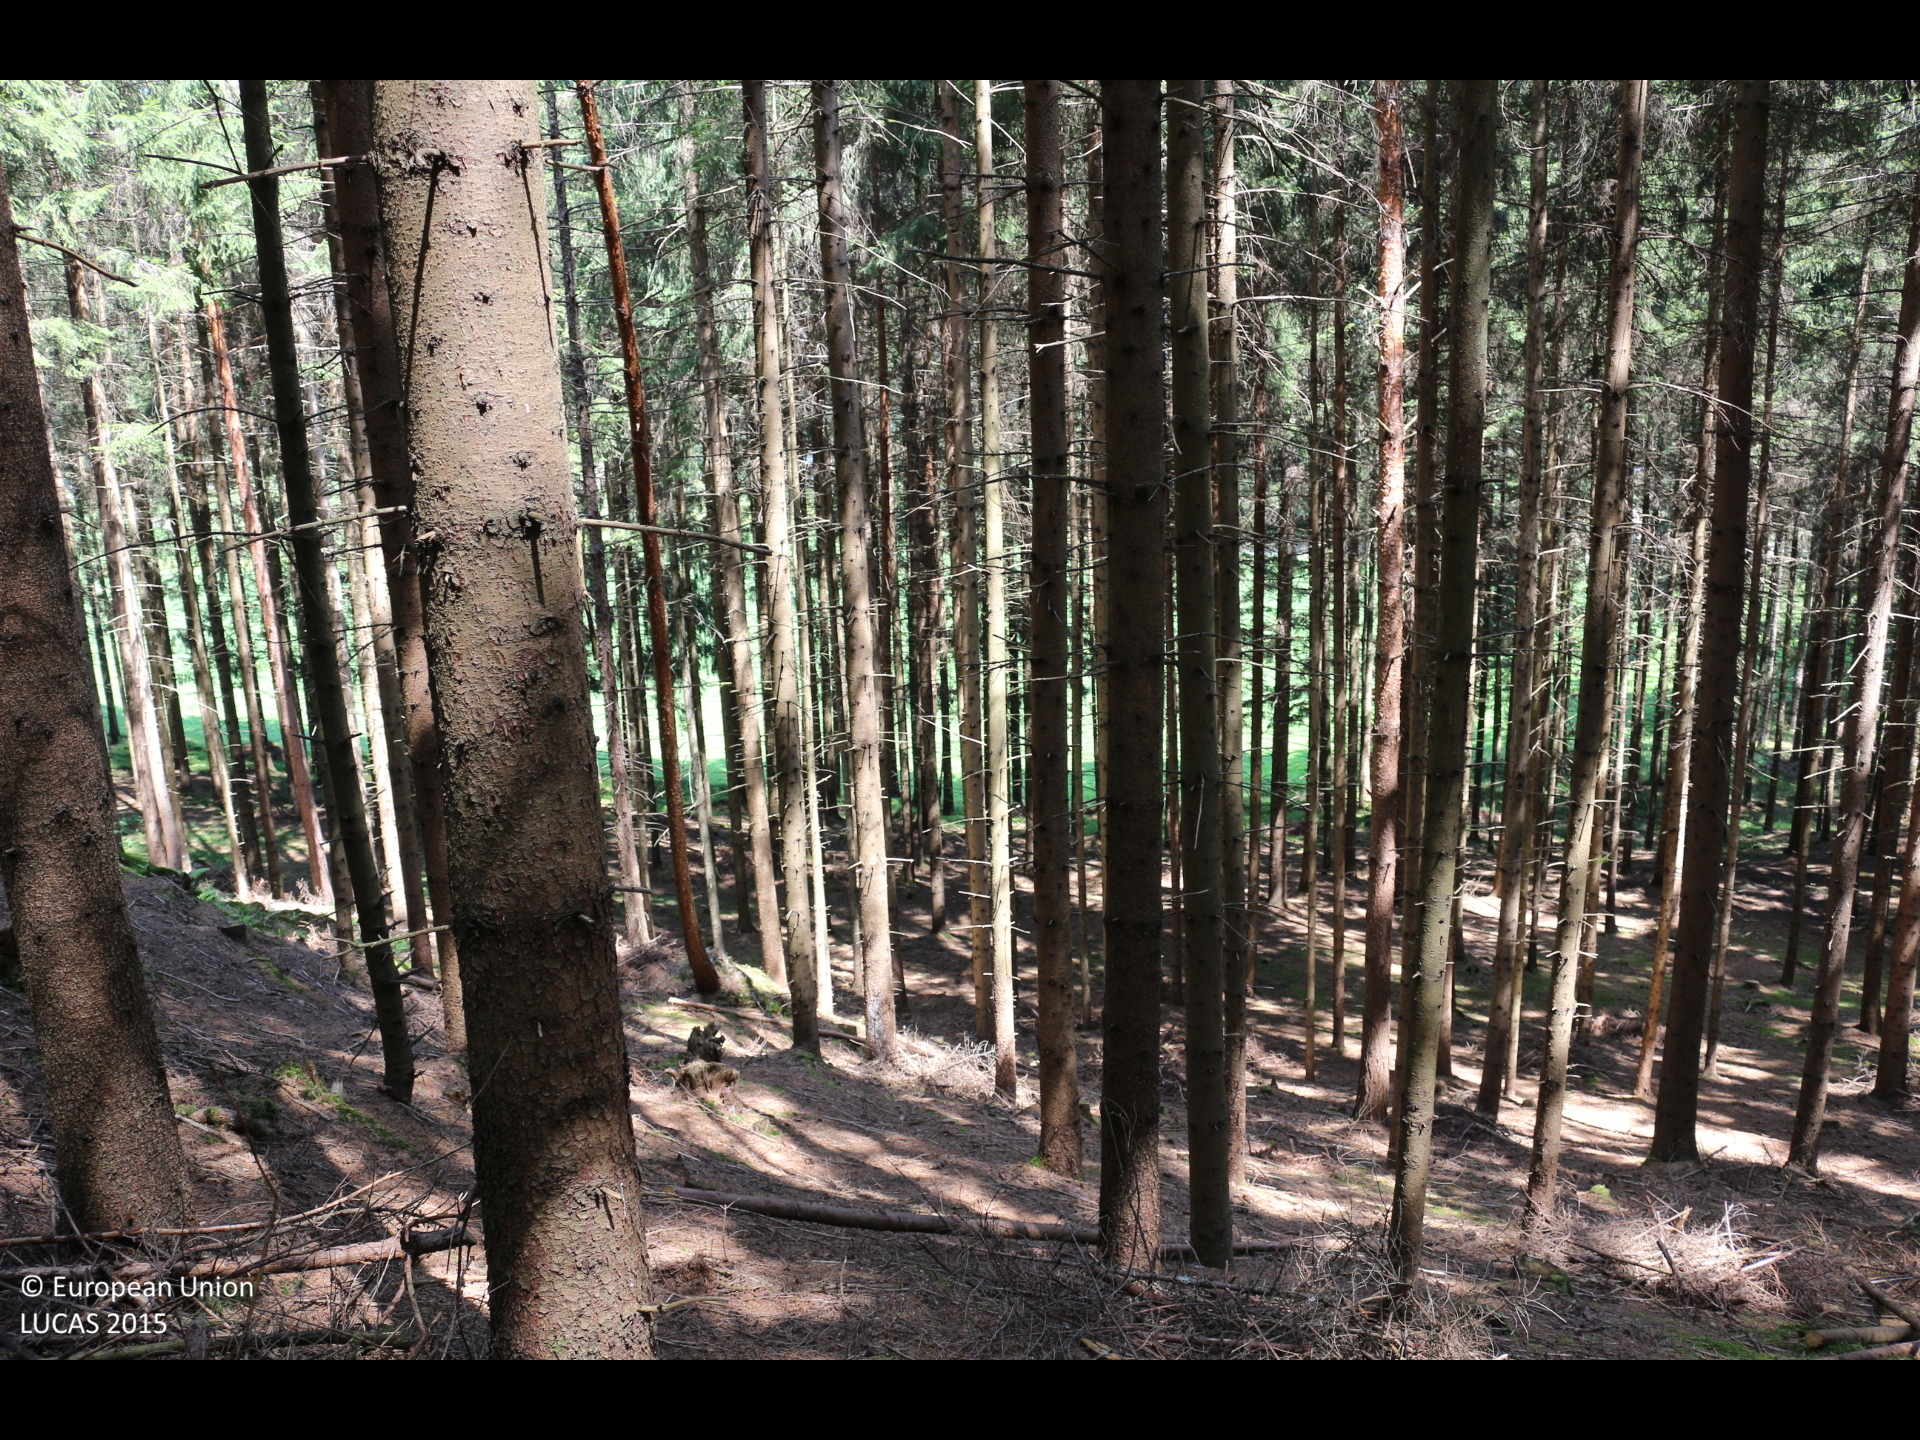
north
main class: Woodland
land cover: Spruce dominated coniferous woodland
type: alpine coniferous forest
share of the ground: > 75 %
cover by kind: coniferous forest trees 100 %
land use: Forestry
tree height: > 5 m
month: July
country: AT
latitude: 46.7235
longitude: 13.5954
